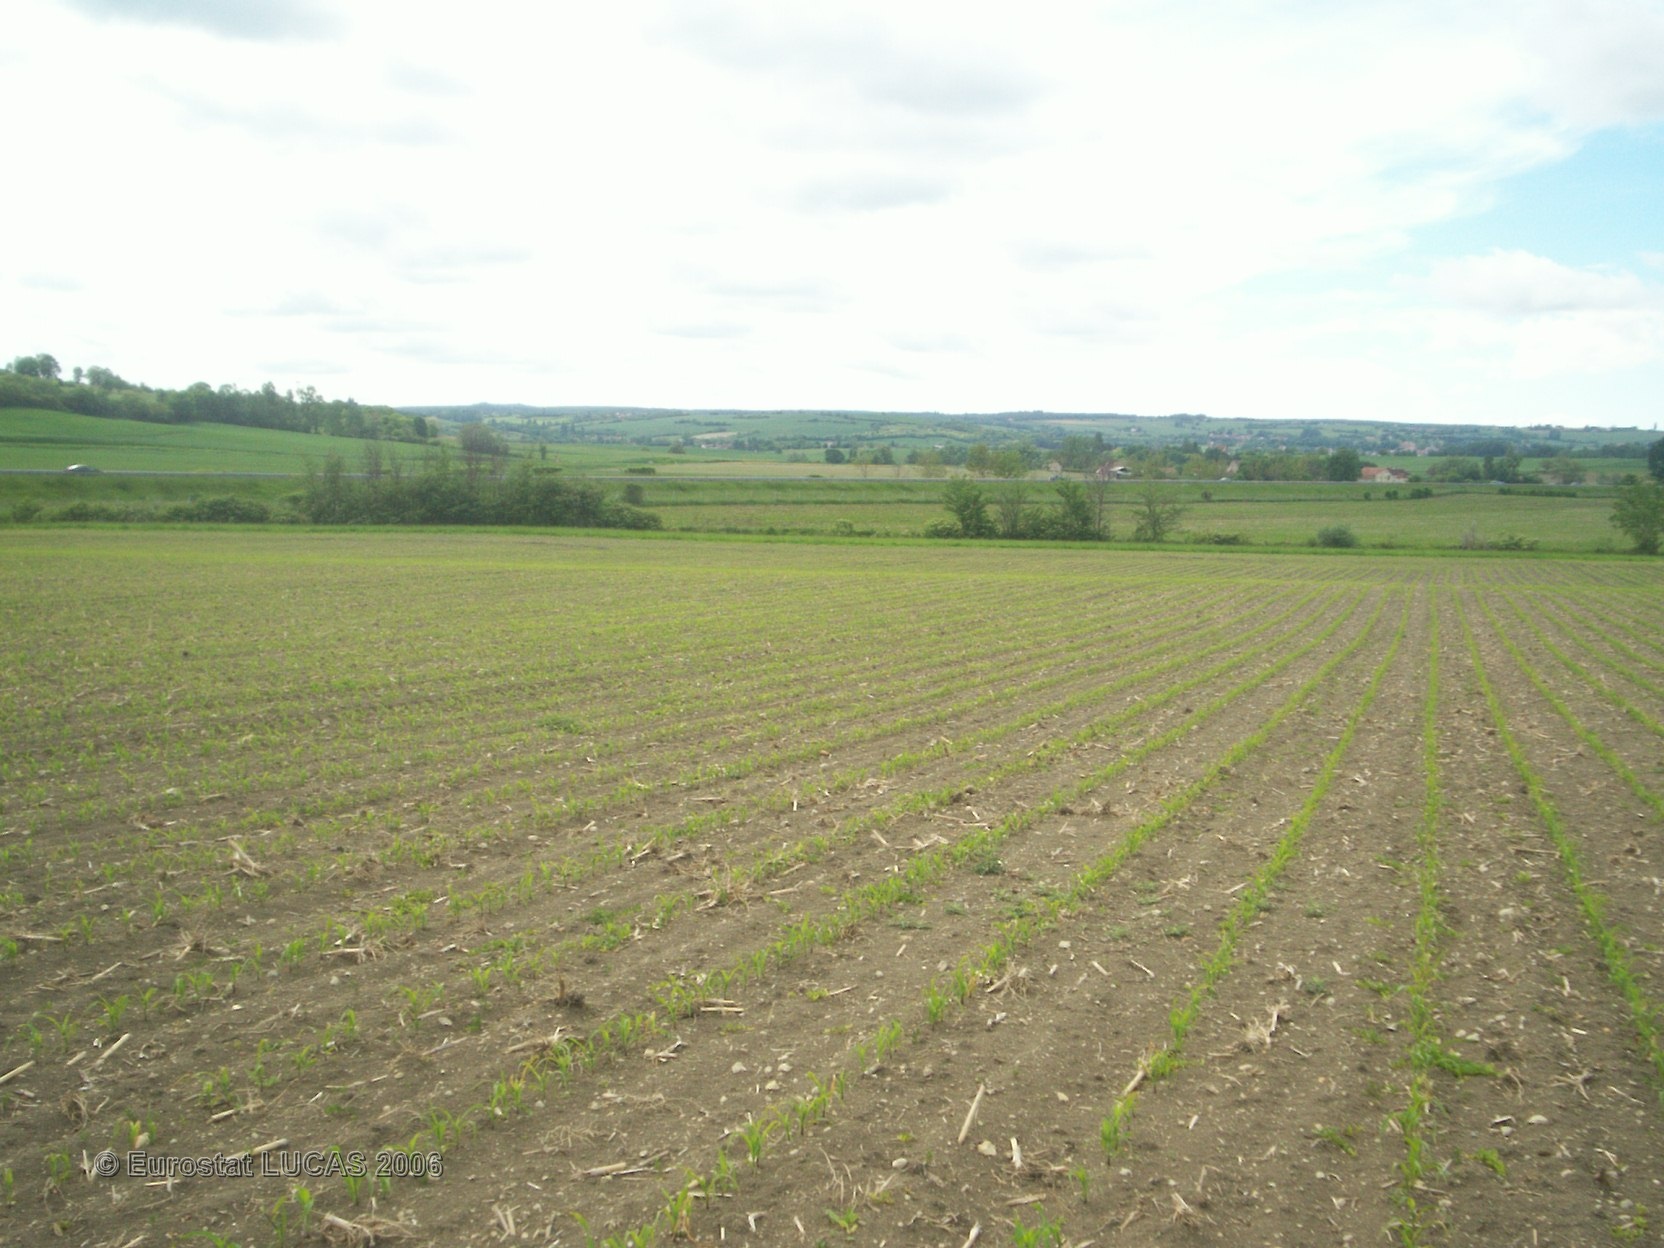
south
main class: Cropland
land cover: Maize
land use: Agriculture (excluding fallow land and kitchen gardens)
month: May
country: FR
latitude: 46.1838
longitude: 3.1192
